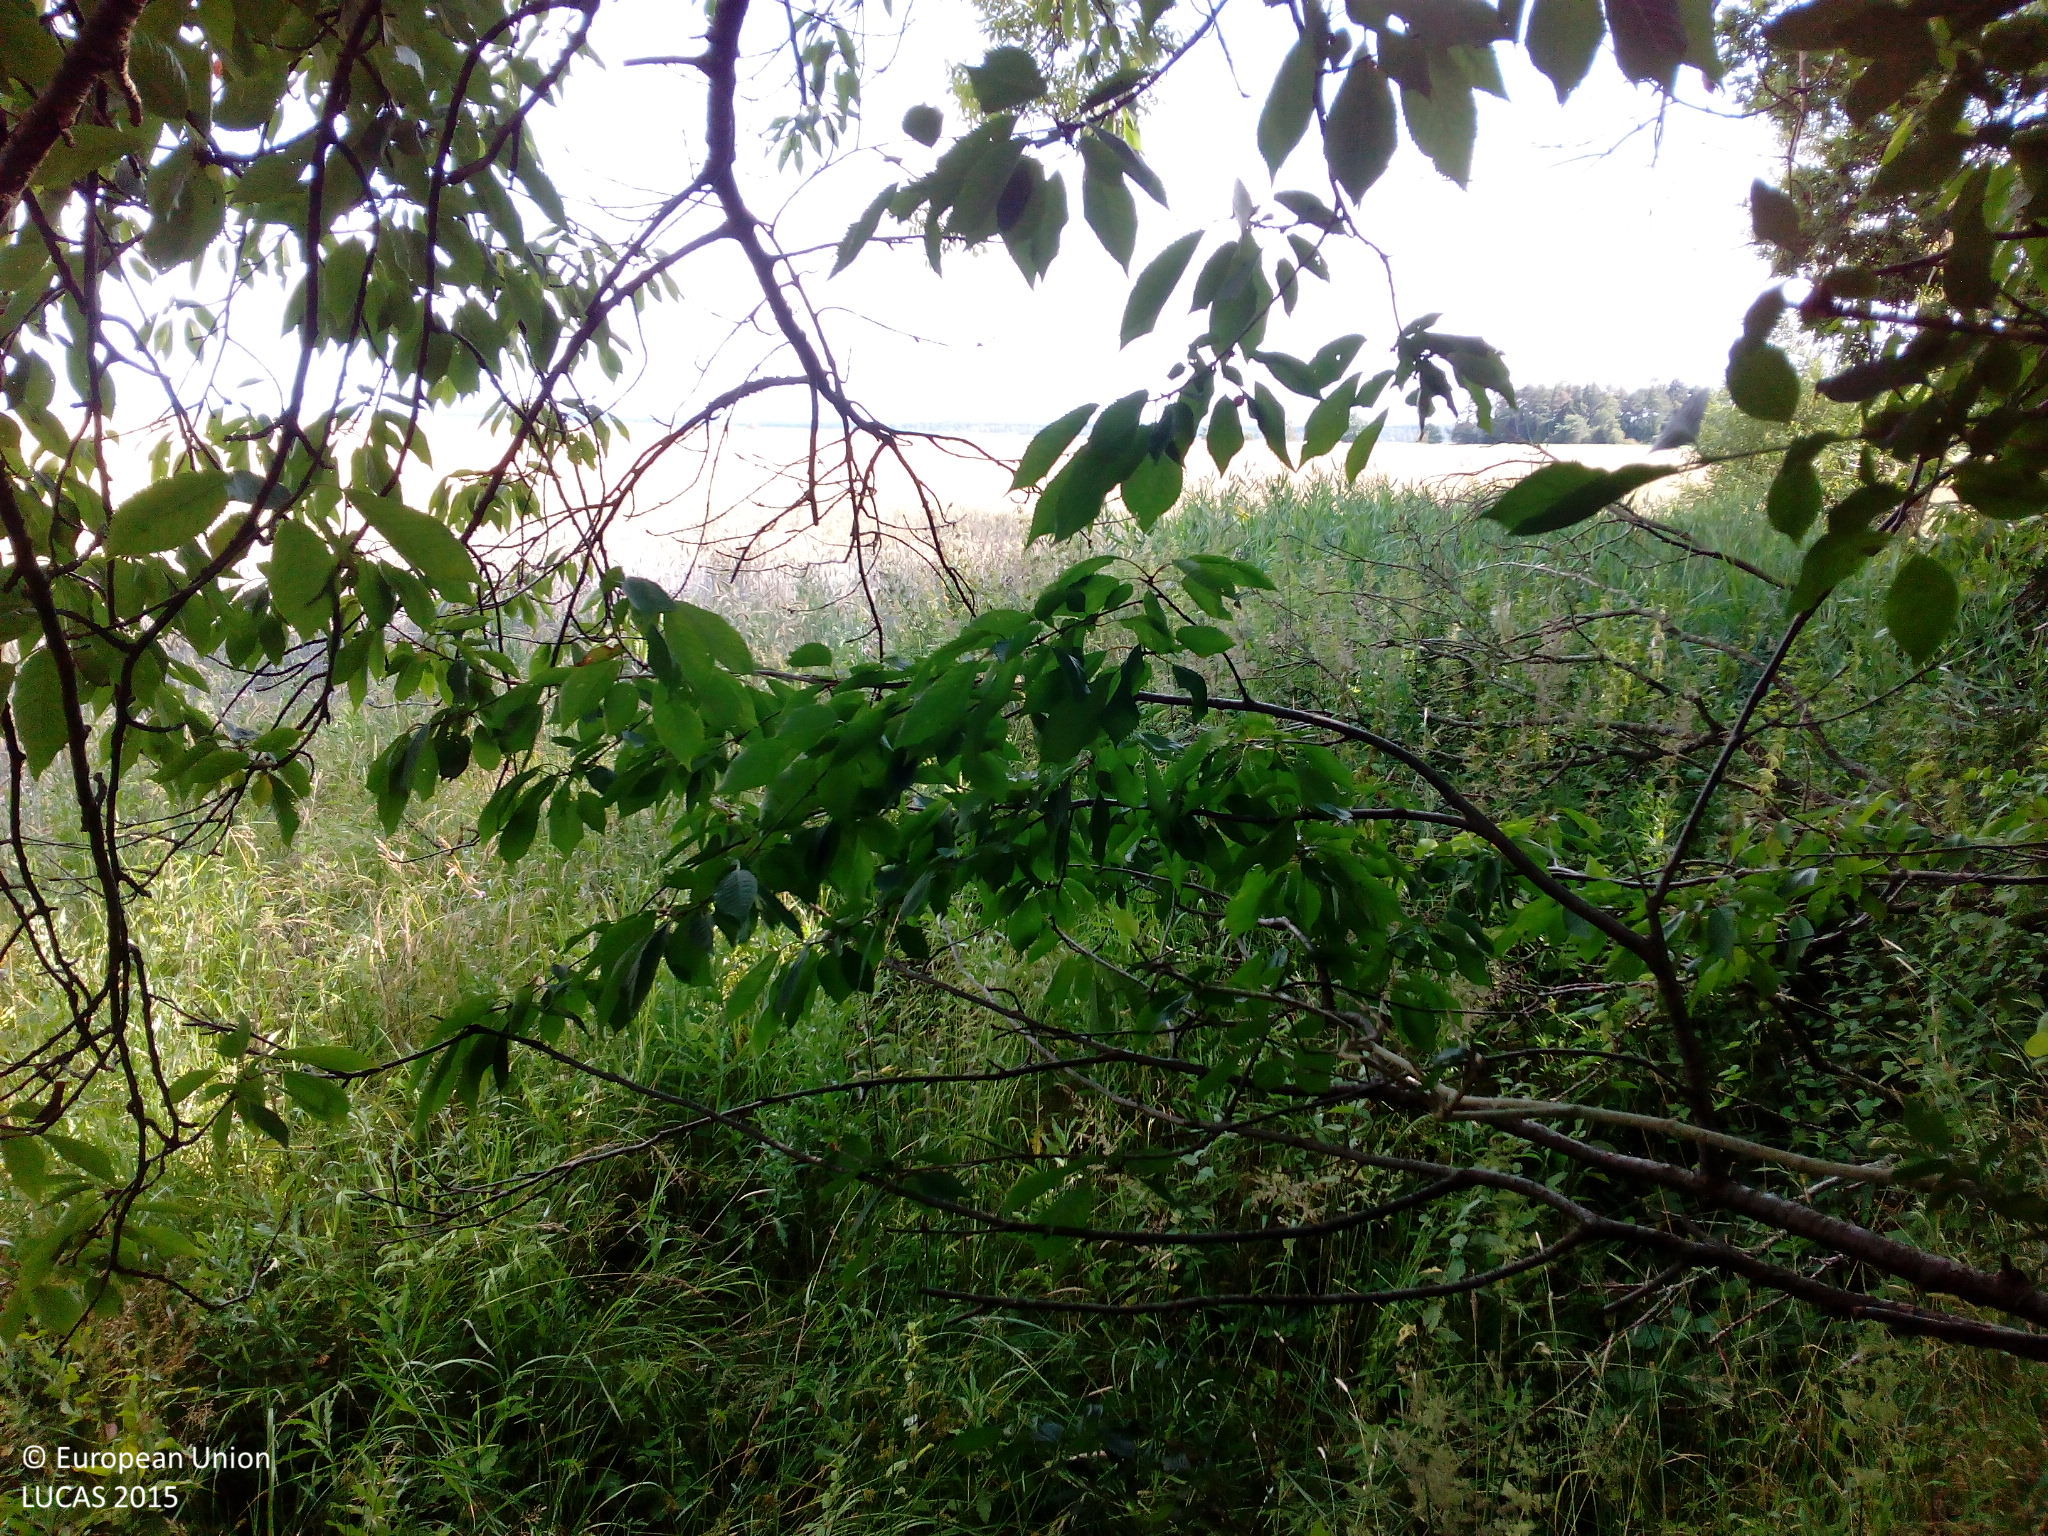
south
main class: Woodland
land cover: Broadleaved woodland
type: acidophilous oak and oak-birch forest
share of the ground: > 75 %
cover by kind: broadleaved forest trees 100 %
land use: Forestry
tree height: > 5 m
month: July
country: DK
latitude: 55.9574
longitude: 11.9362
